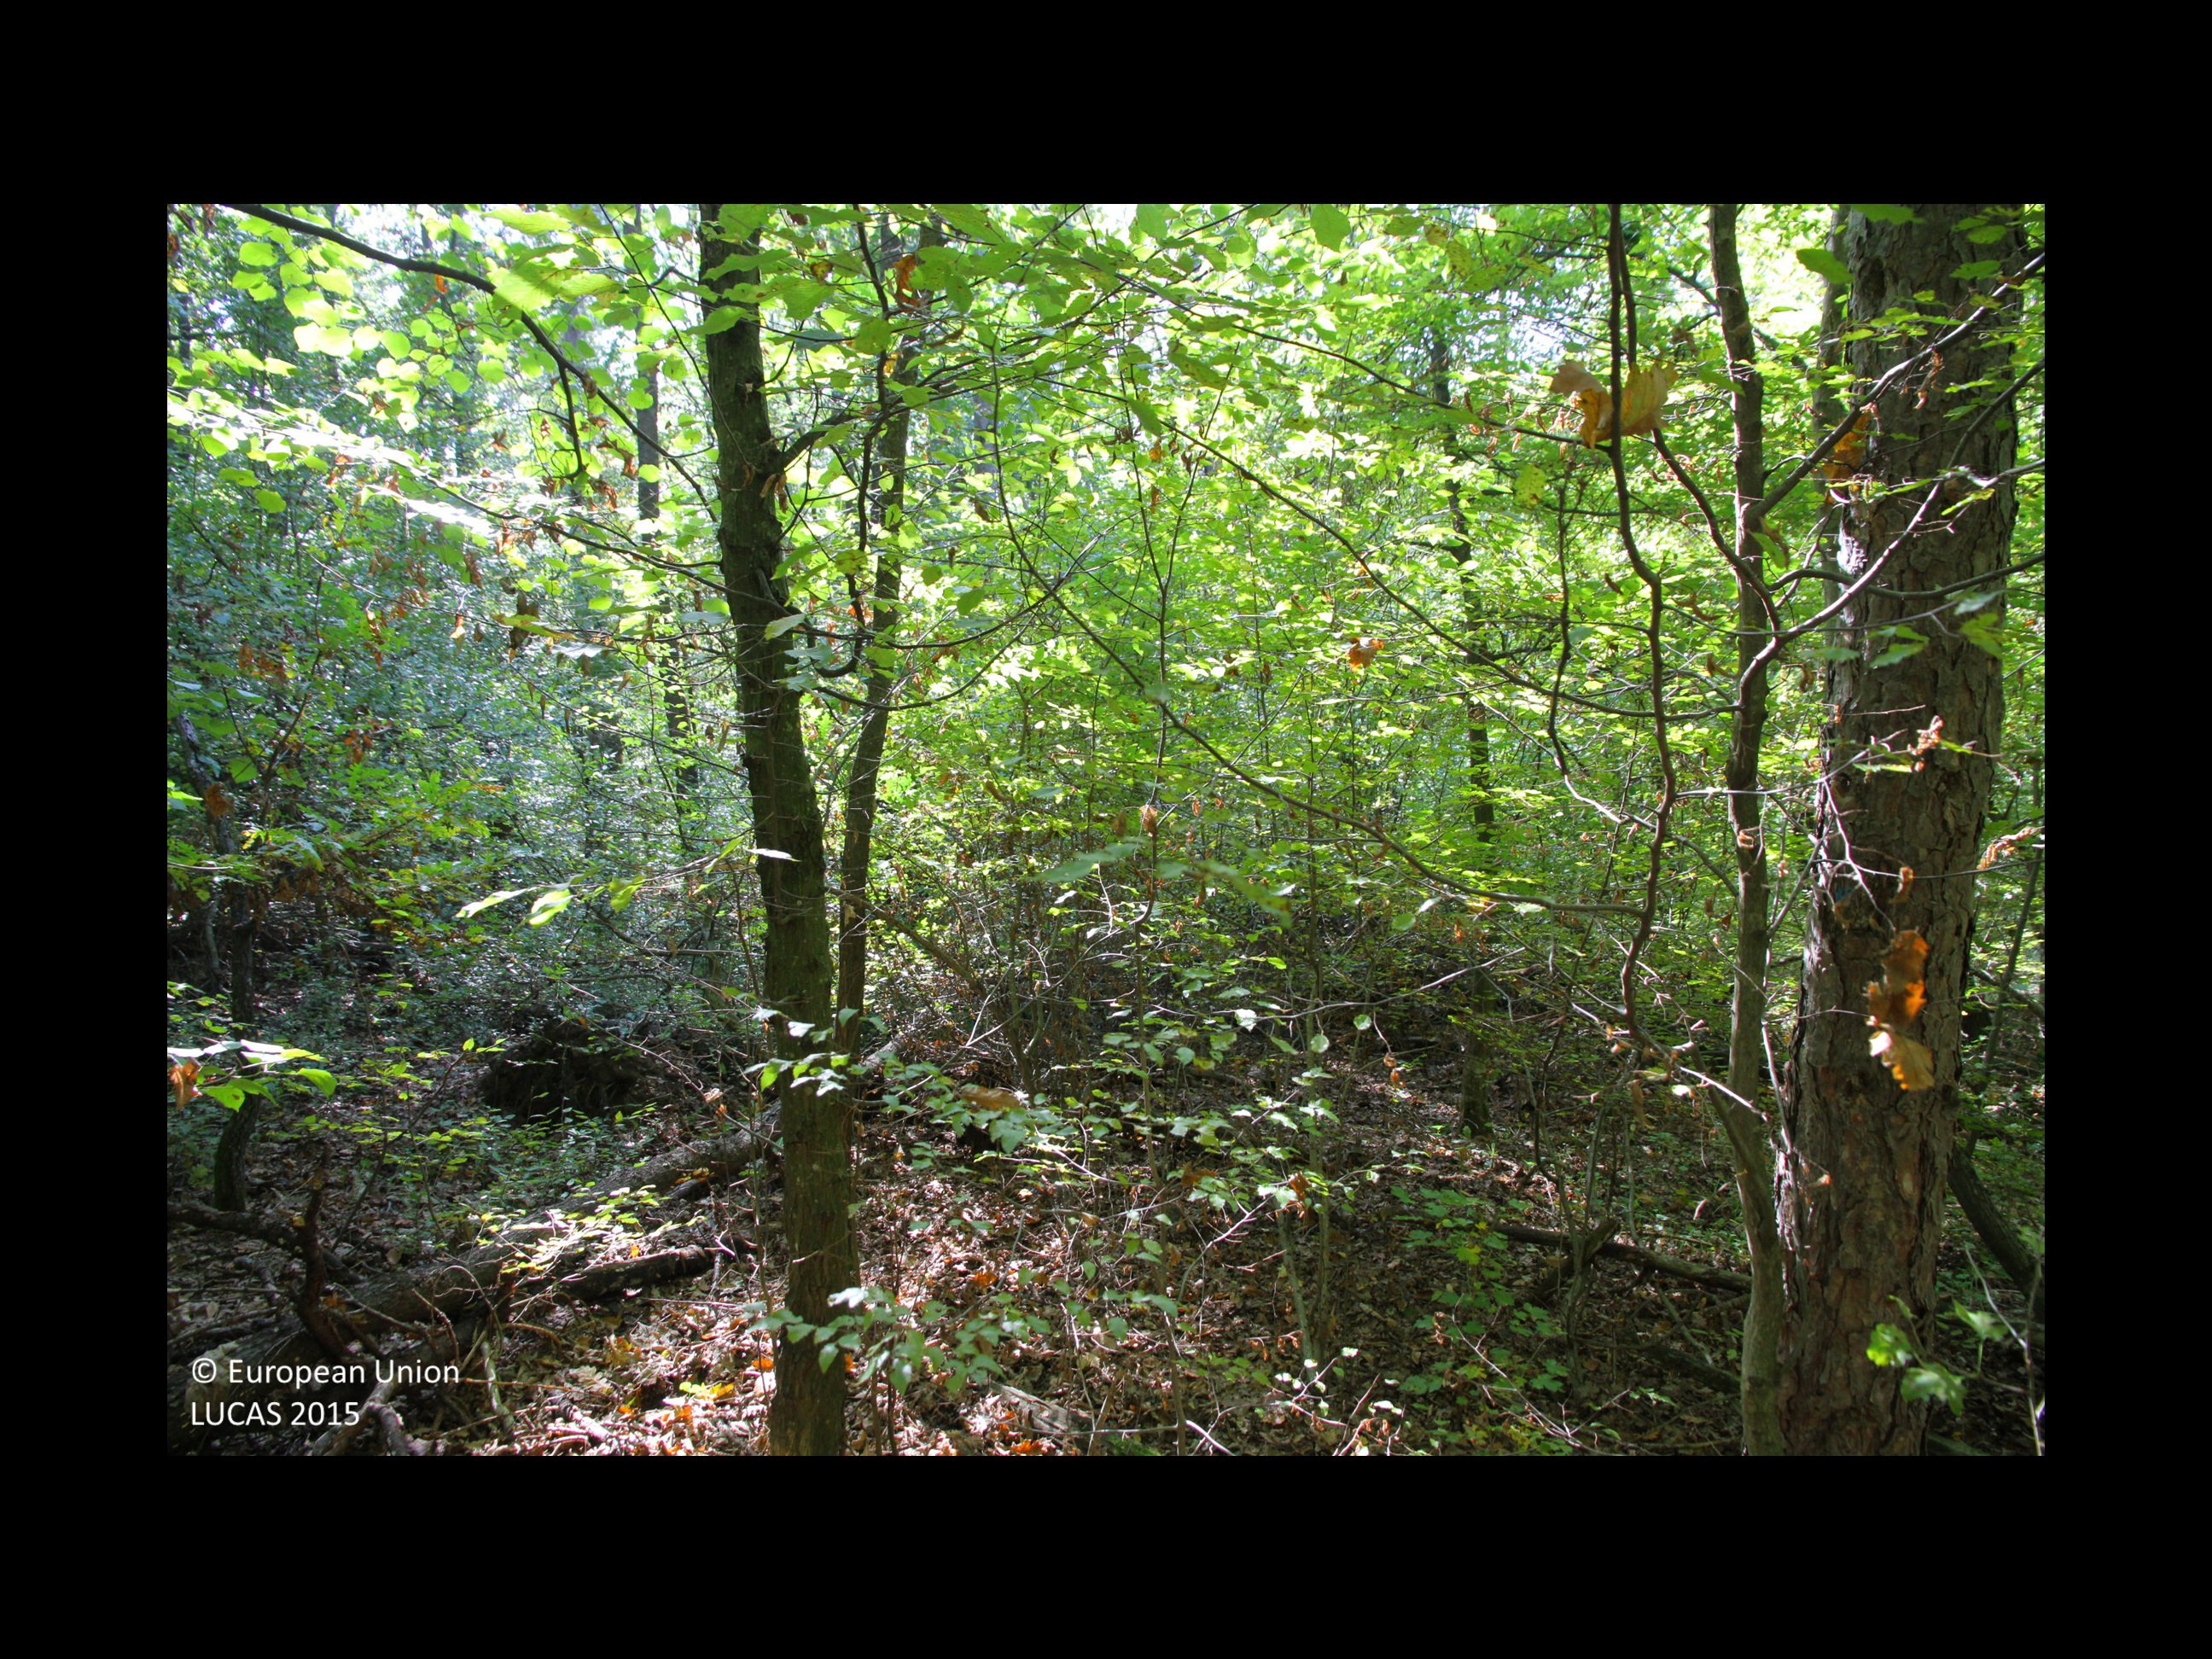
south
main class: Woodland
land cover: Broadleaved woodland
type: mesophytic deciduous forest
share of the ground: > 75 %
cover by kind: broadleaved forest trees 100 %
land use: Forestry
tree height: > 5 m
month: October
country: BG
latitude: 43.0202
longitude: 26.9329
